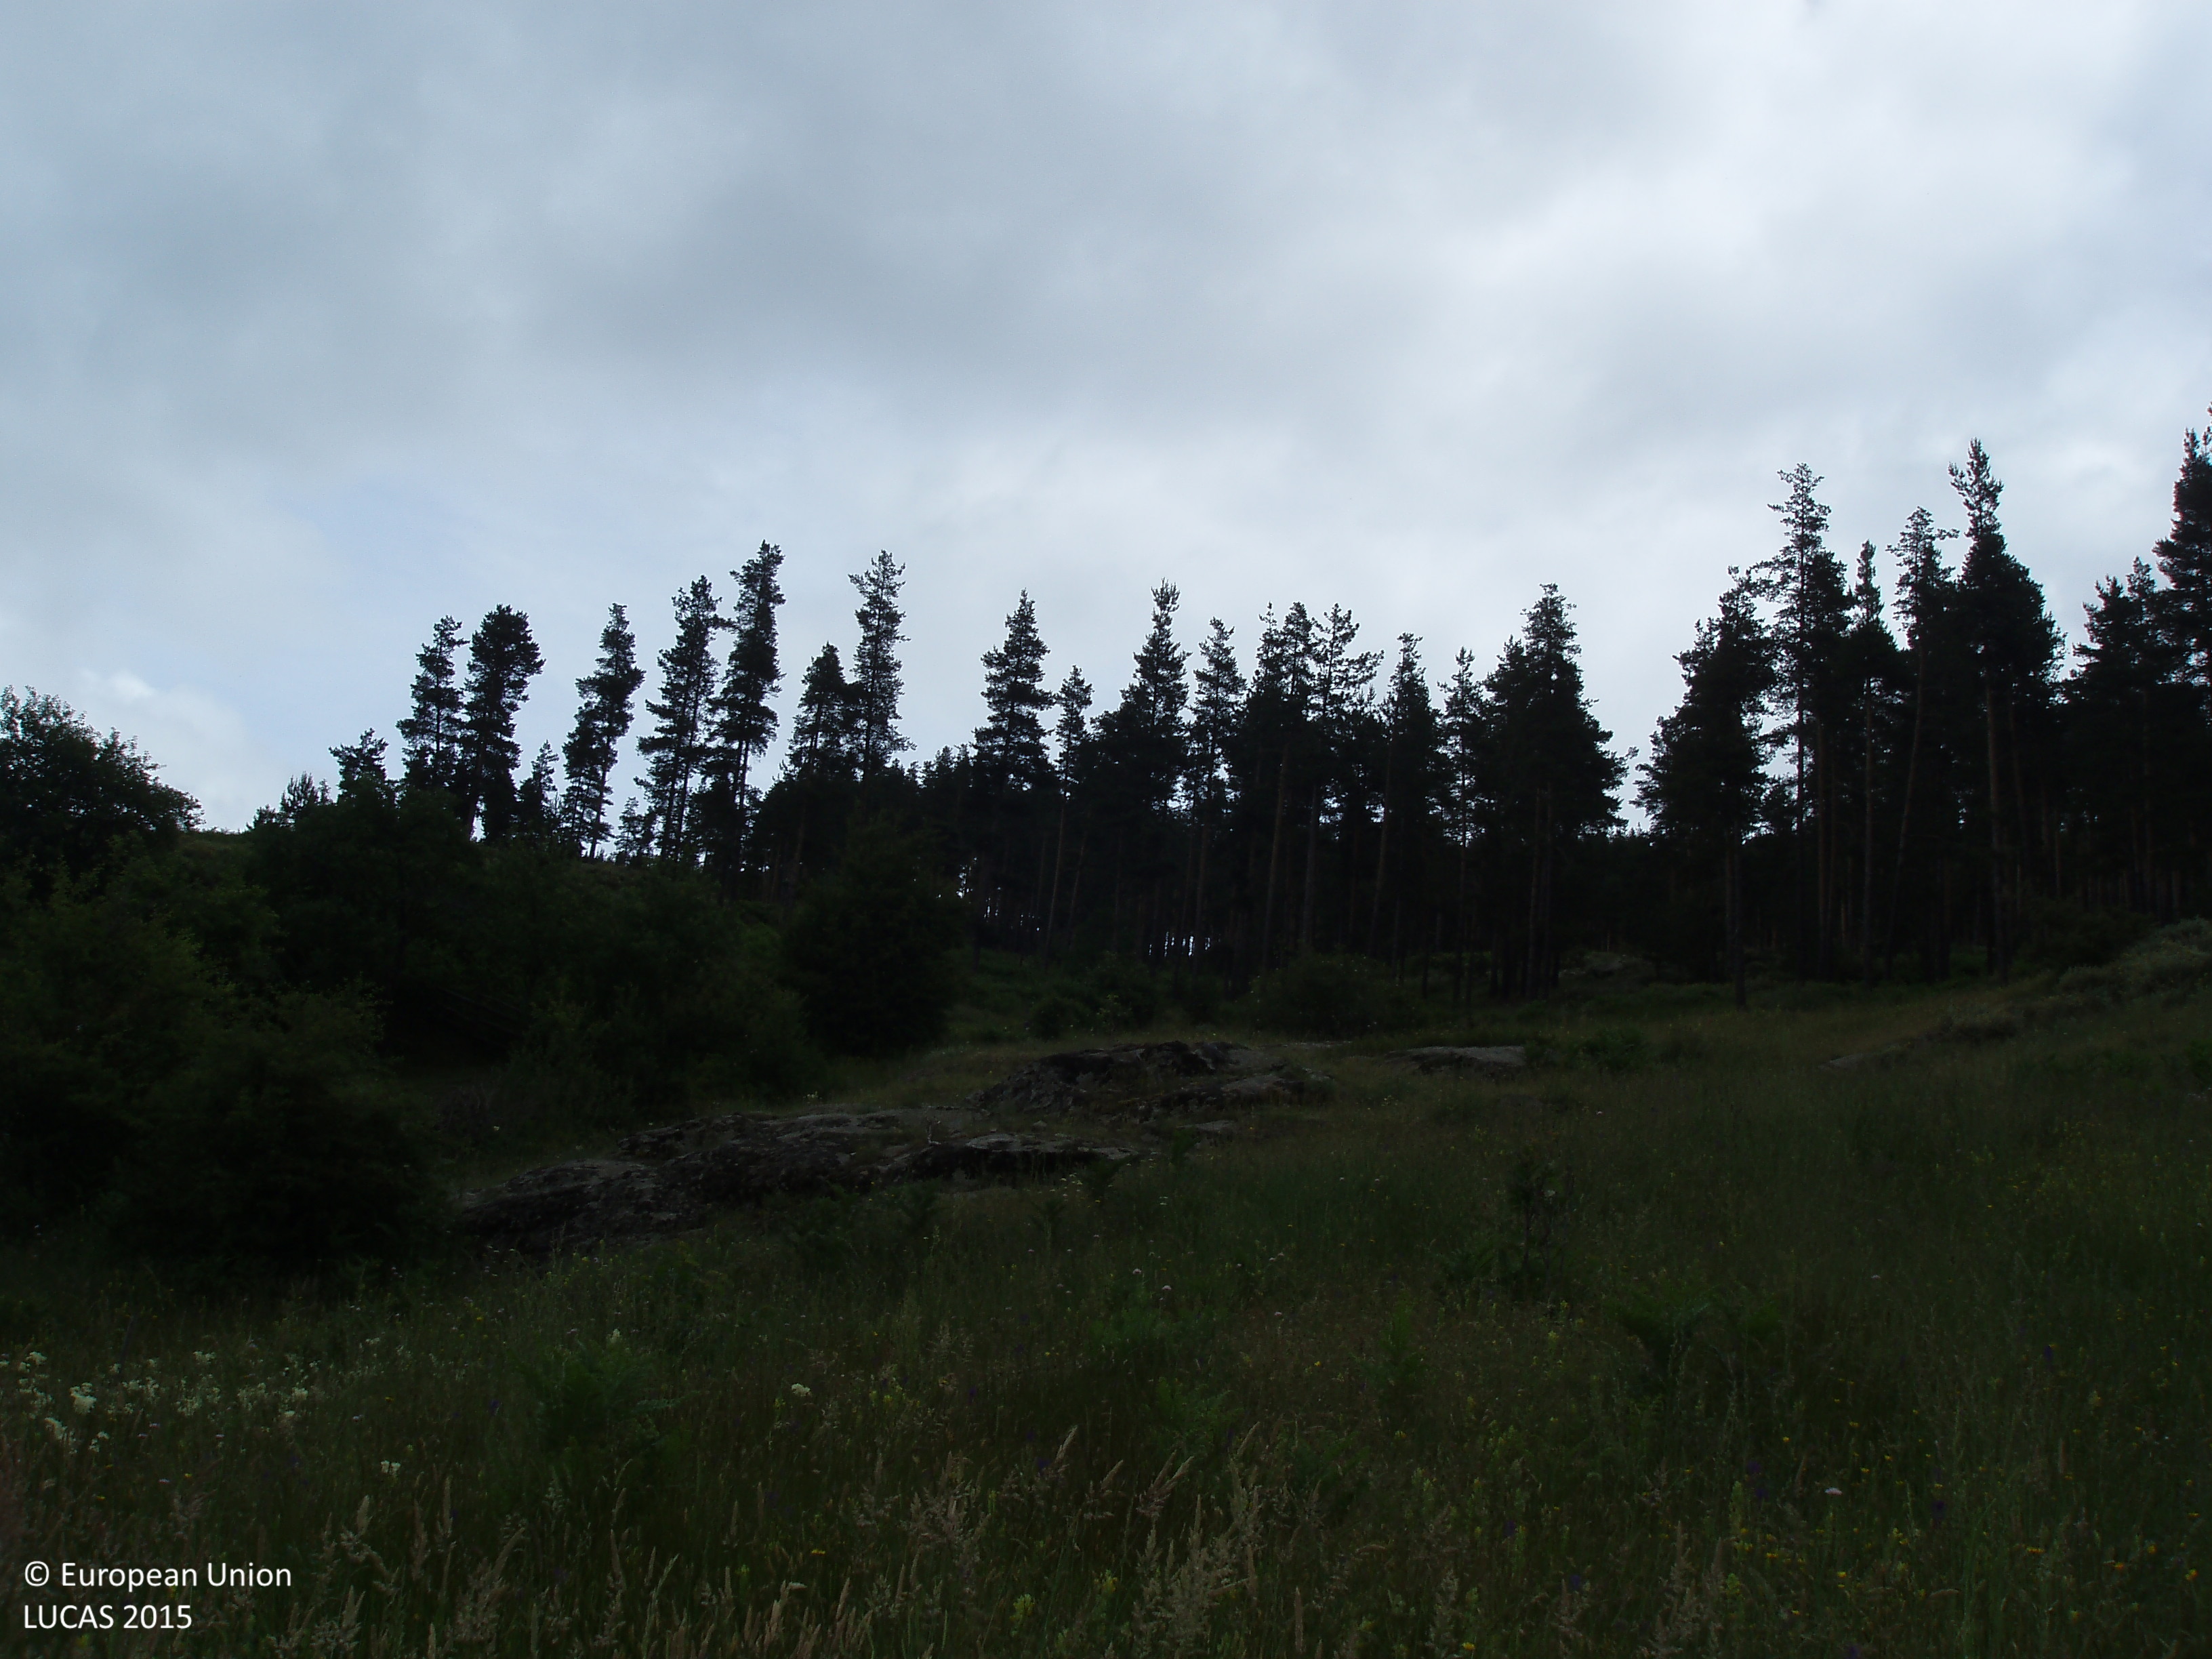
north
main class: Grassland
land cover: Grassland without tree/shrub cover
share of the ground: > 75 %
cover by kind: herbaceous plants 100 %
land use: Agriculture (excluding fallow land and kitchen gardens)
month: June
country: BG
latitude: 41.7266
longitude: 23.7711
